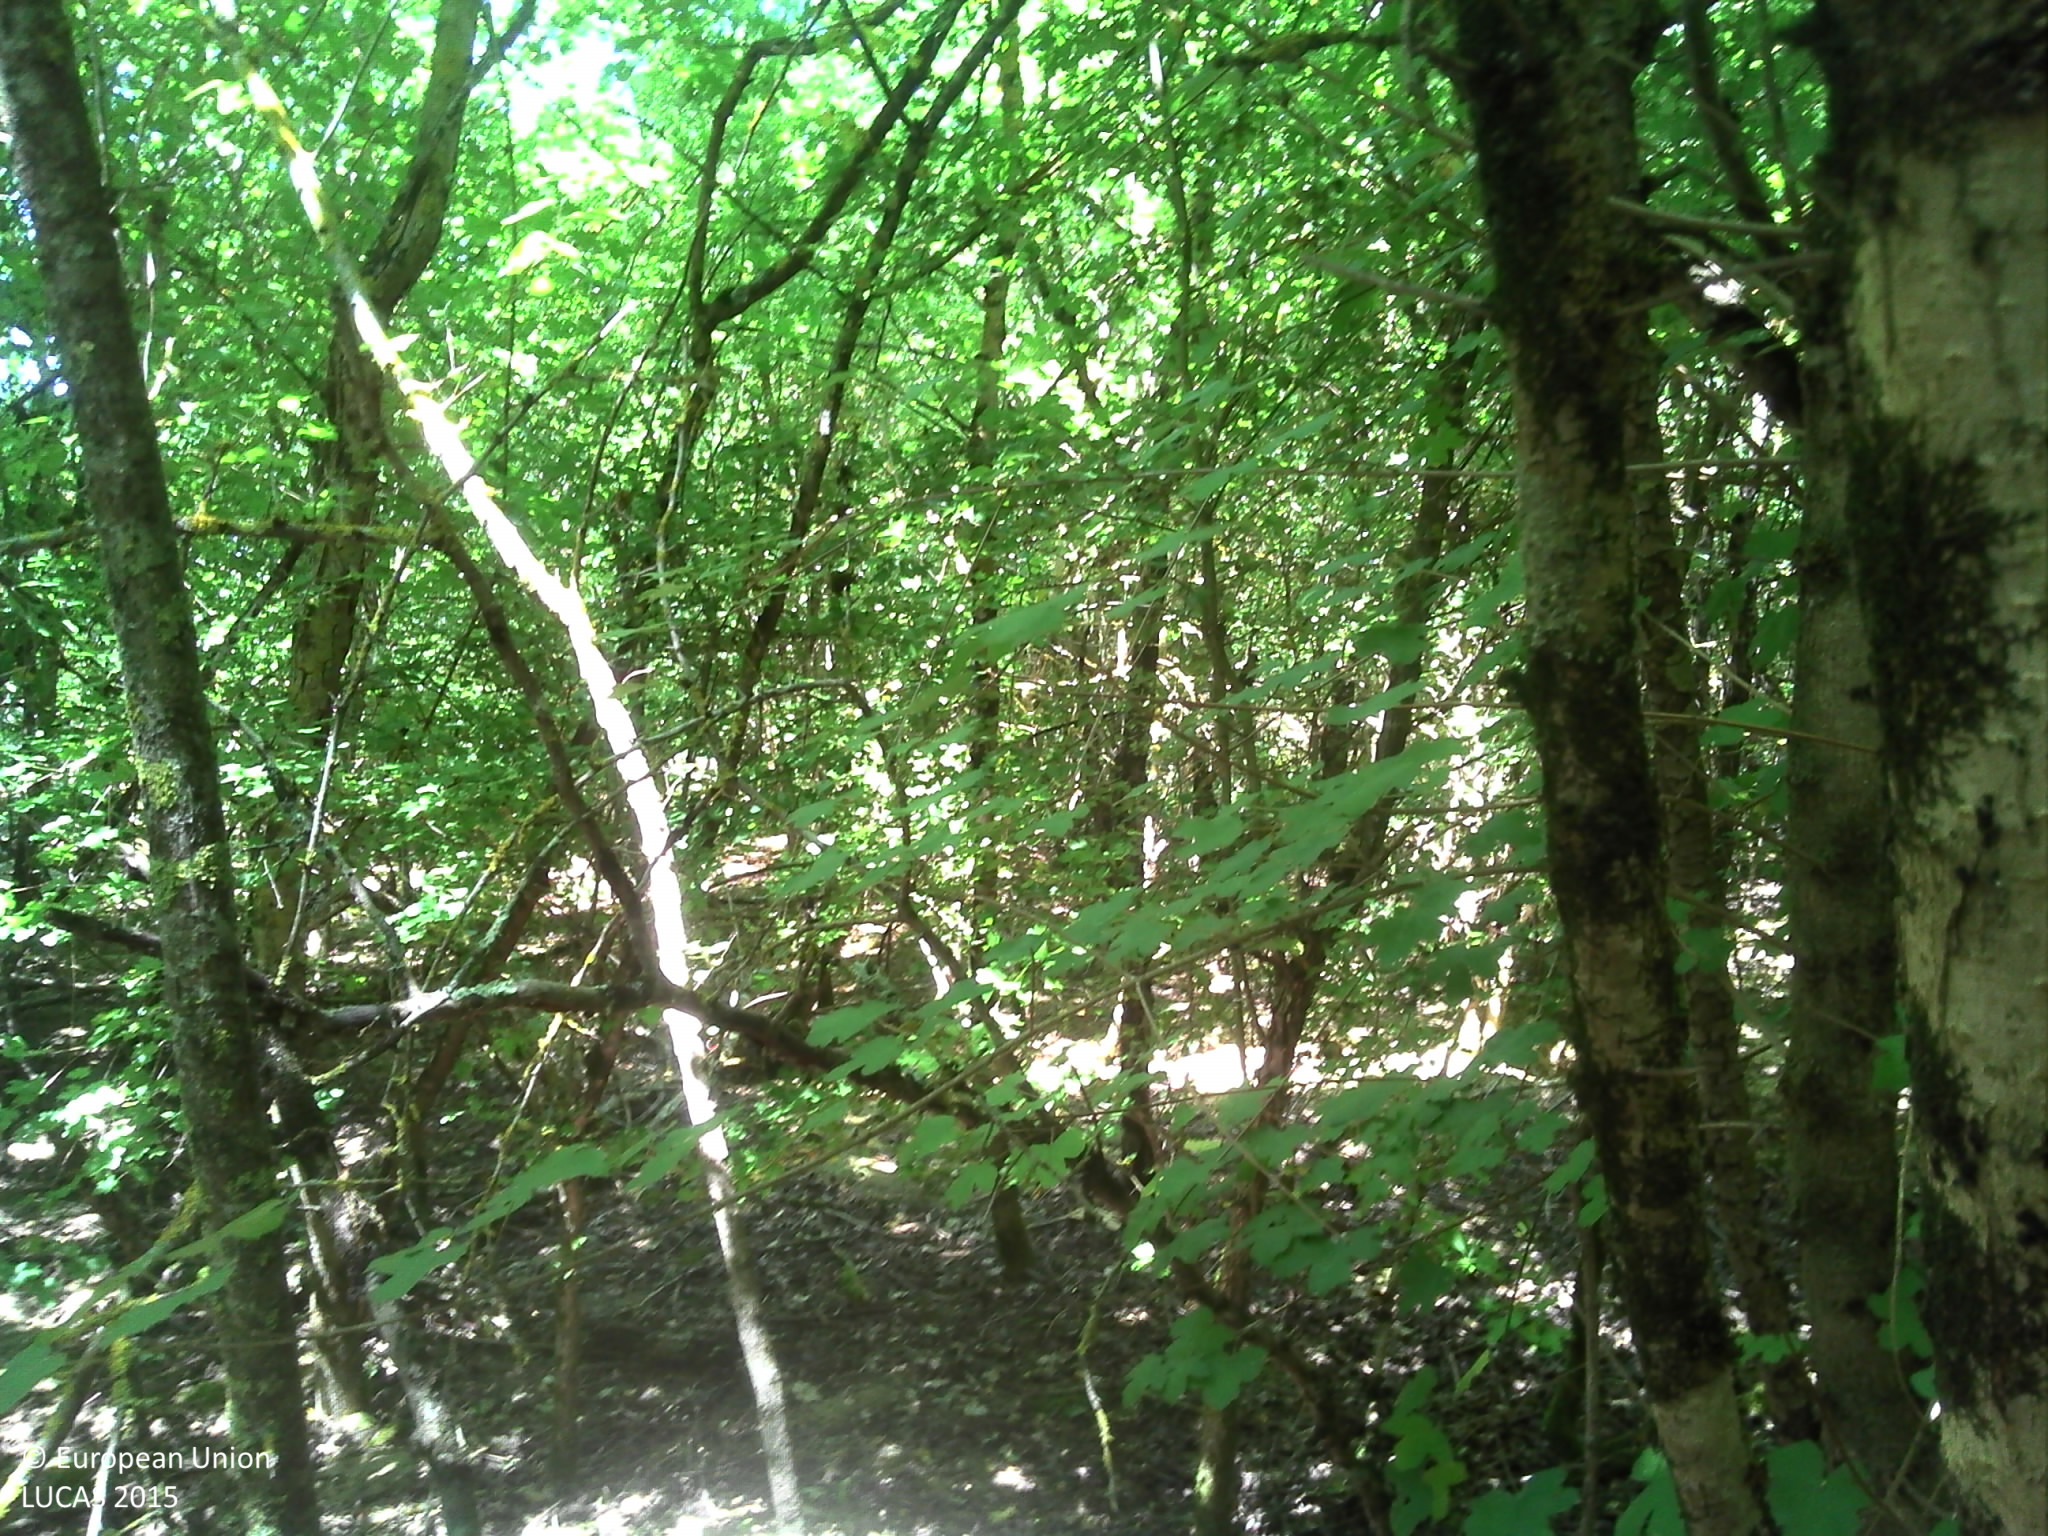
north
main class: Woodland
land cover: Broadleaved woodland
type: mesophytic deciduous forest
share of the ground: > 75 %
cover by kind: broadleaved forest trees 100 %
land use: Forestry
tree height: > 5 m
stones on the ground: < 10 %
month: June
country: FR
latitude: 43.6056
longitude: 1.9891
